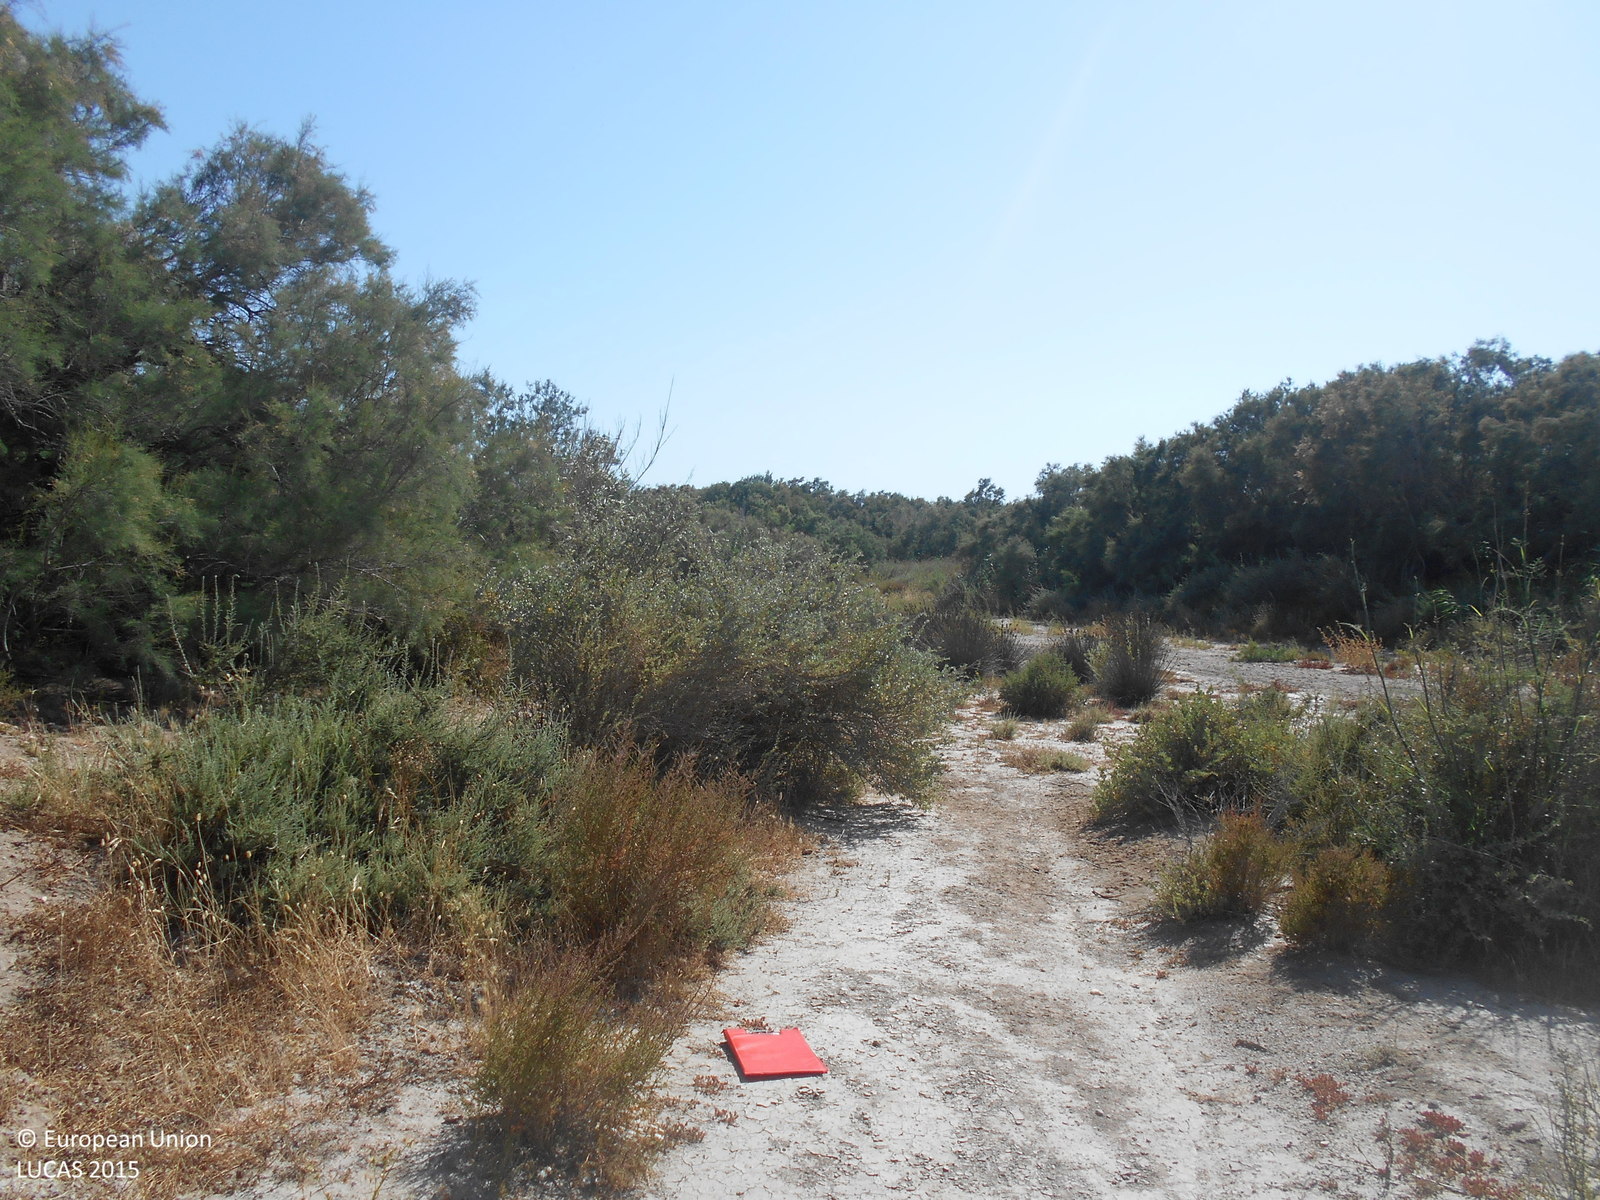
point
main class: Shrubland
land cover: Shrubland without tree cover
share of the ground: 25 - 50 %
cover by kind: shrubs 40 %, unconsolidated bare surface 40 %, herbaceous plants 20 %
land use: Semi-natural and natural areas not in use
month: May
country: ES
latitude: 36.8061
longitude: -2.2468
